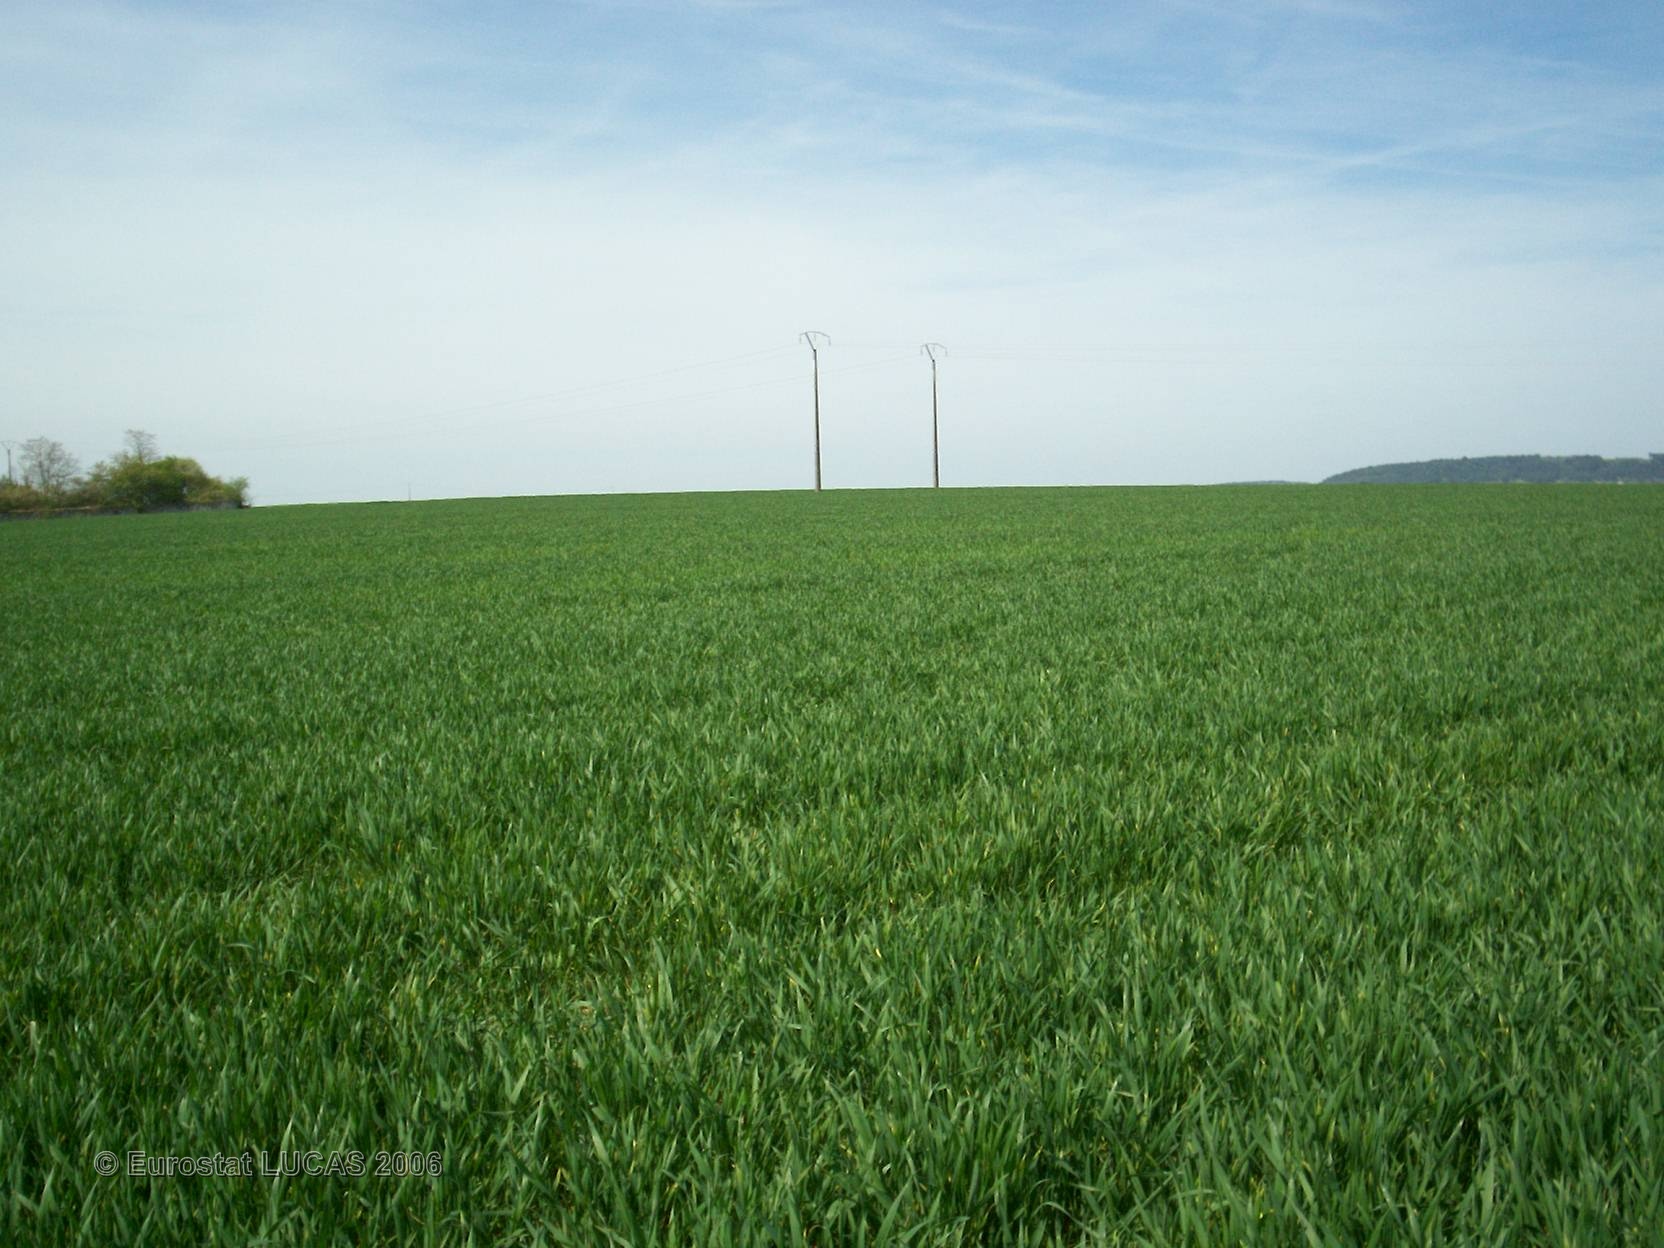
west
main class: Cropland
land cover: Common wheat
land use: Agriculture (excluding fallow land and kitchen gardens)
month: May
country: FR
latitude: 47.8713
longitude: 4.5303
